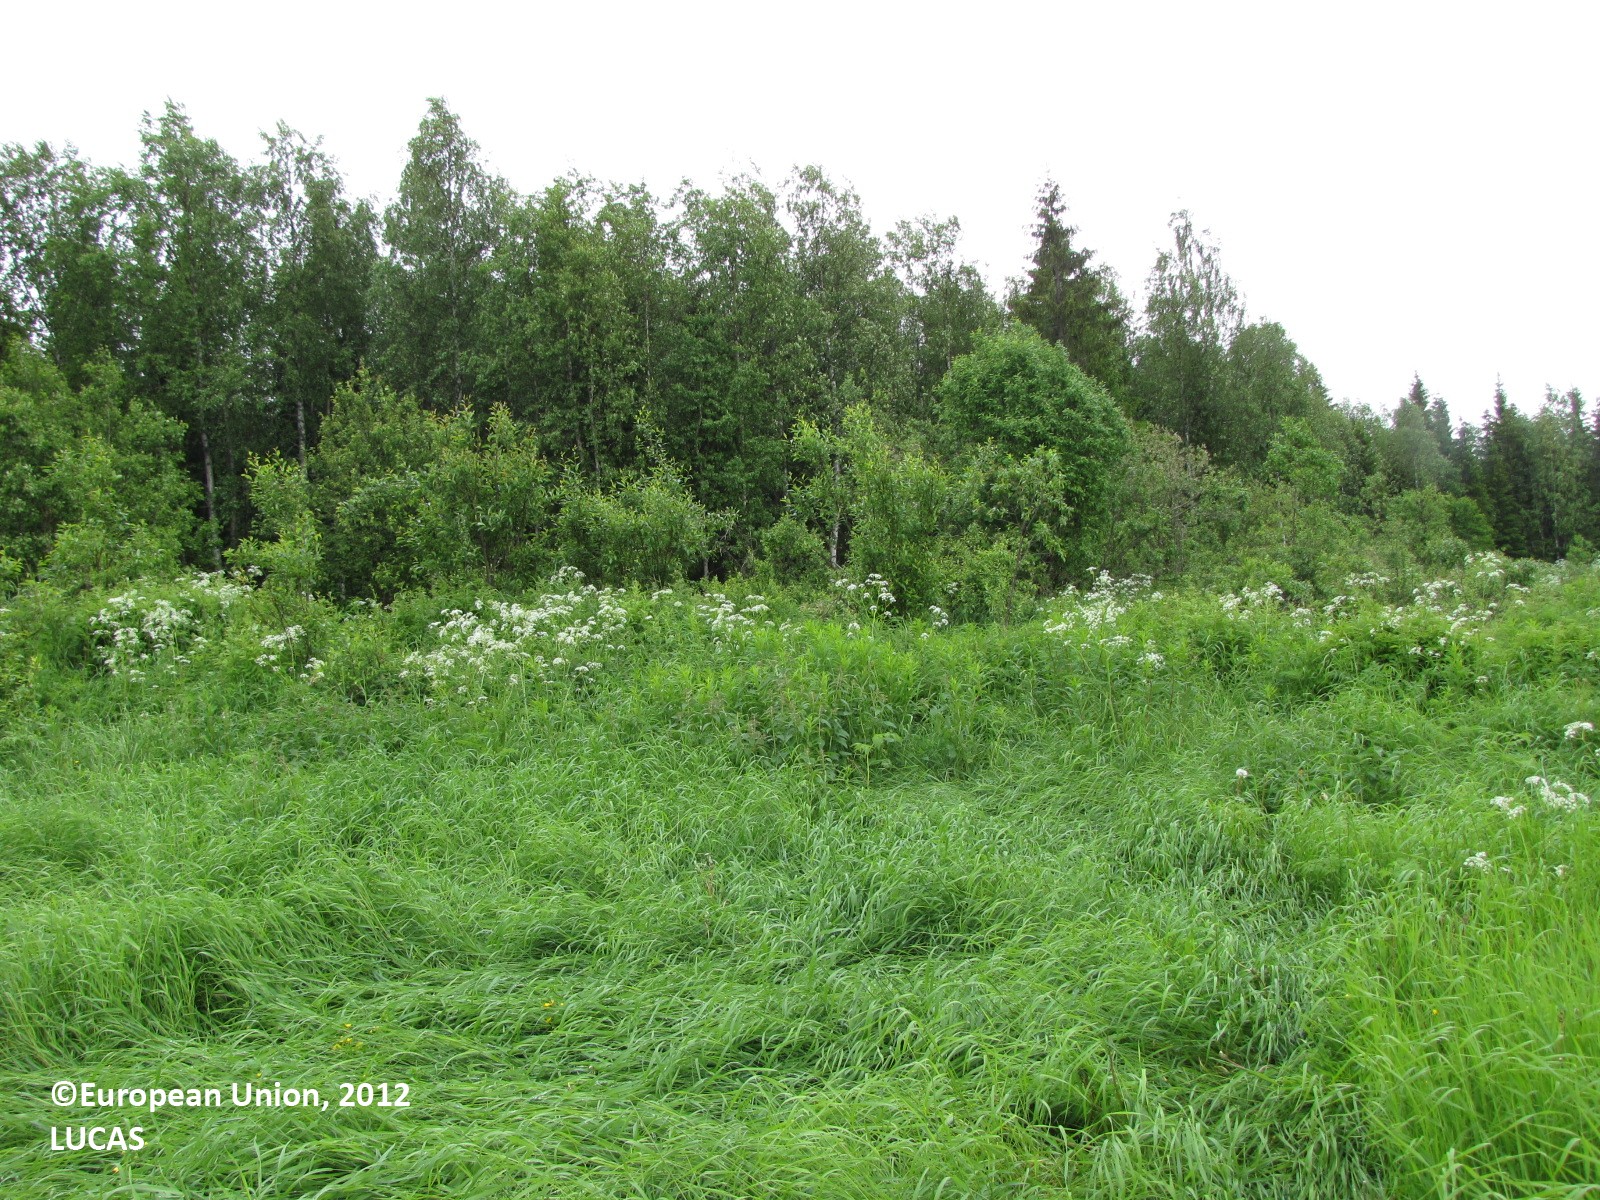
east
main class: Grassland
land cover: Grassland without tree/shrub cover
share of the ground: > 75 %
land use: Agriculture (excluding fallow land and kitchen gardens)
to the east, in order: Grassland without tree/shrub cover; Spontaneously vegetated surfaces; Ditches and canals; Spontaneously vegetated surfaces; Spruce dominated mixed woodland; Ditches and canals; Broadleaved woodland; Ditches and canals; Broadleaved woodland; Ditches and canals; Broadleaved woodland; Spruce dominated mixed woodland; Spruce dominated coniferous woodland; Spruce dominated mixed woodland; Ditches and canals; Spruce dominated mixed woodland
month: July
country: FI
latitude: 66.1077
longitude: 24.4984
